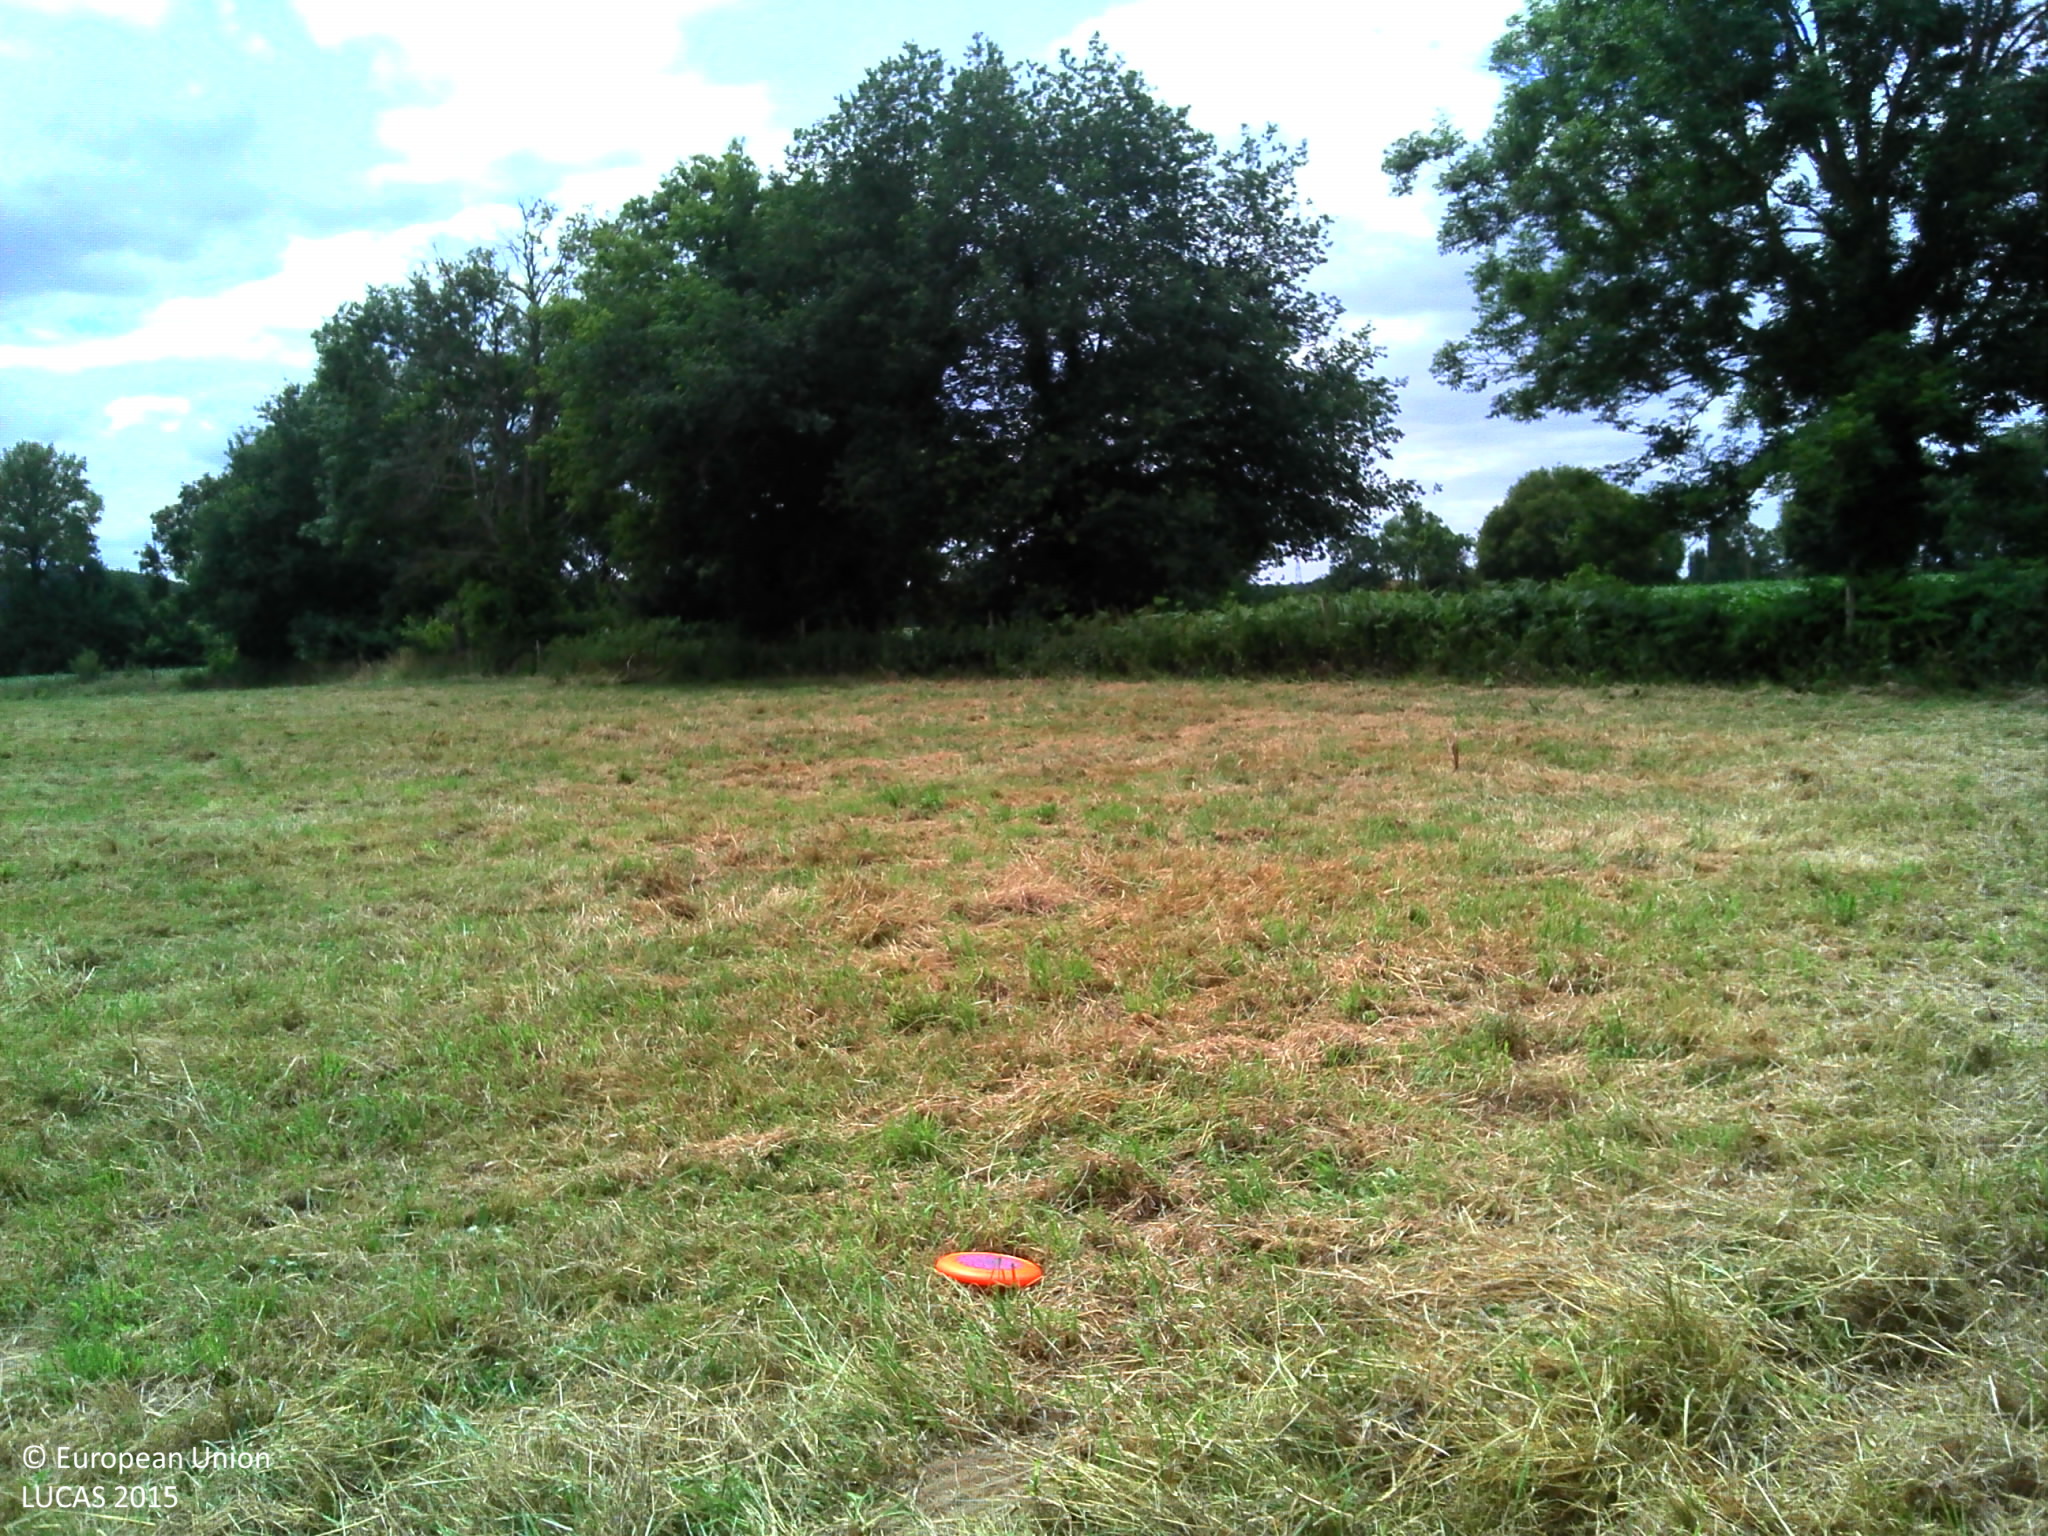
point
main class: Grassland
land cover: Grassland without tree/shrub cover
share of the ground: > 75 %
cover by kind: herbaceous plants 100 %
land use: Agriculture (excluding fallow land and kitchen gardens)
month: June
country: FR
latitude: 47.8682
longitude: 0.3099
